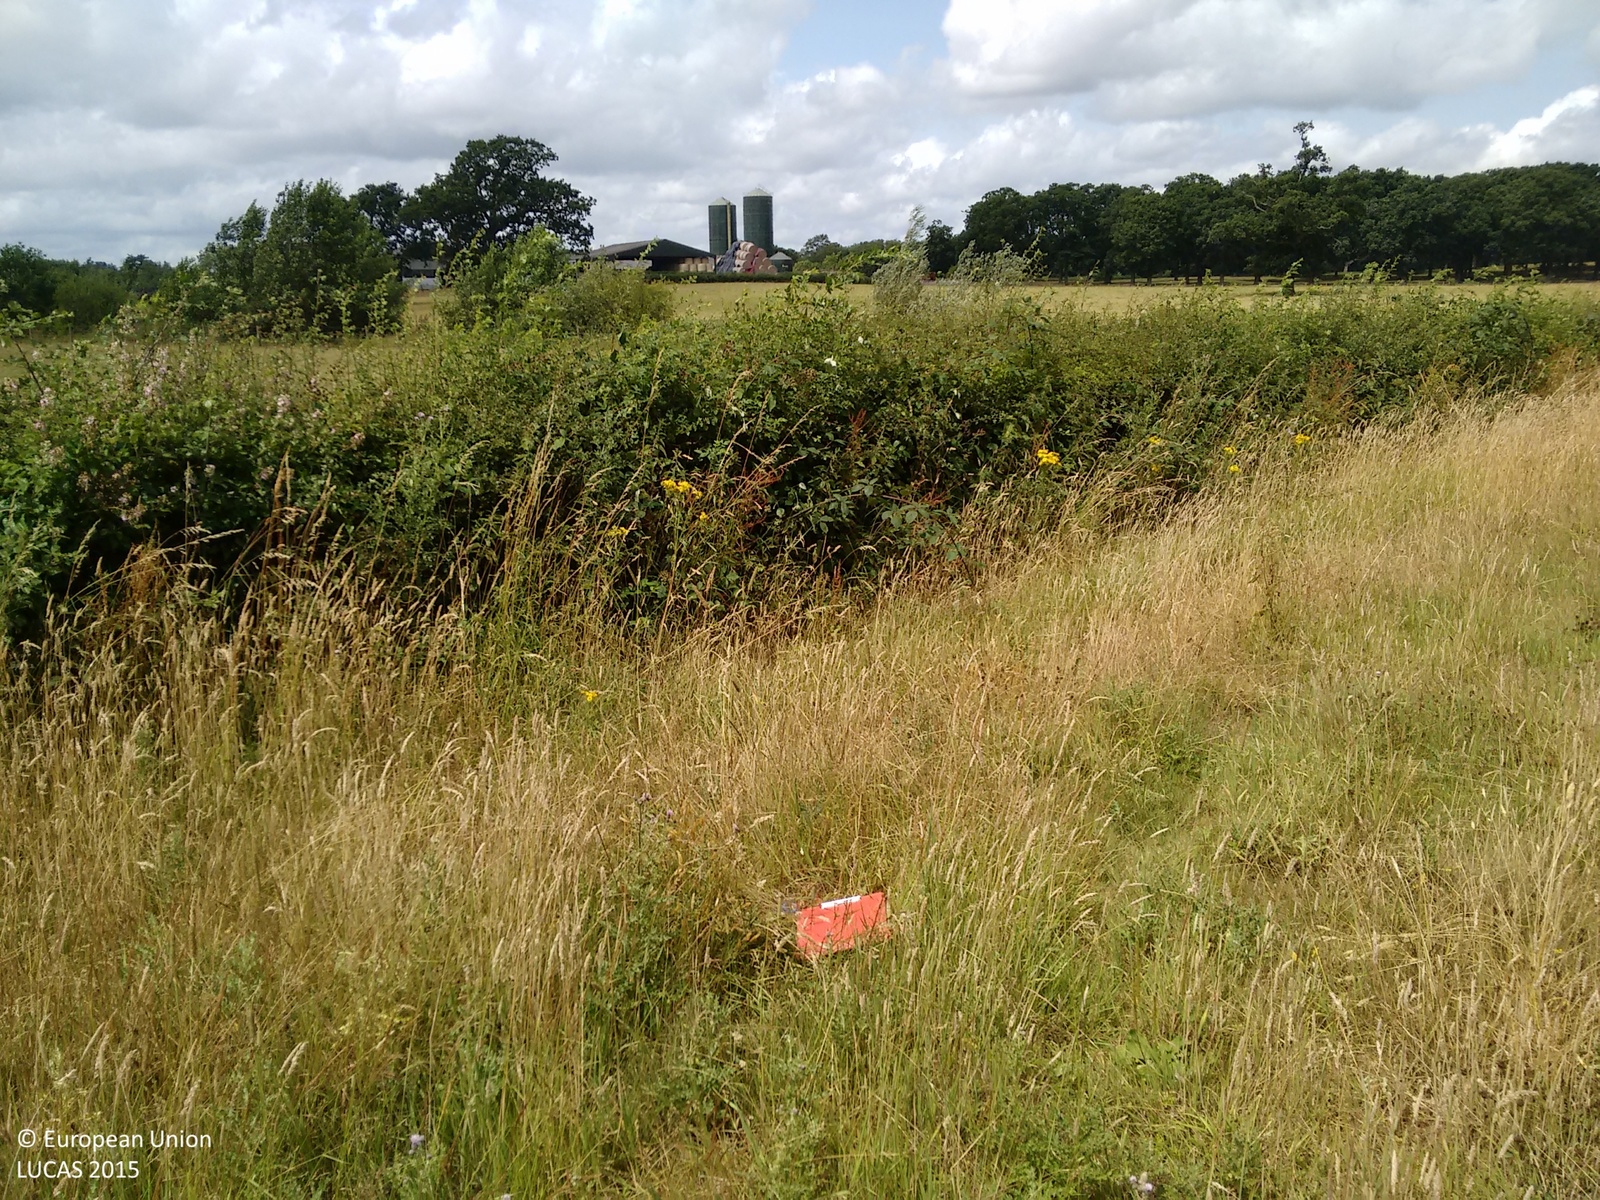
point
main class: Grassland
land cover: Grassland without tree/shrub cover
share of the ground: > 75 %
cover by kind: herbaceous plants 100 %
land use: Agriculture (excluding fallow land and kitchen gardens)
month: July
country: GB
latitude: 51.1169
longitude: -0.4521
